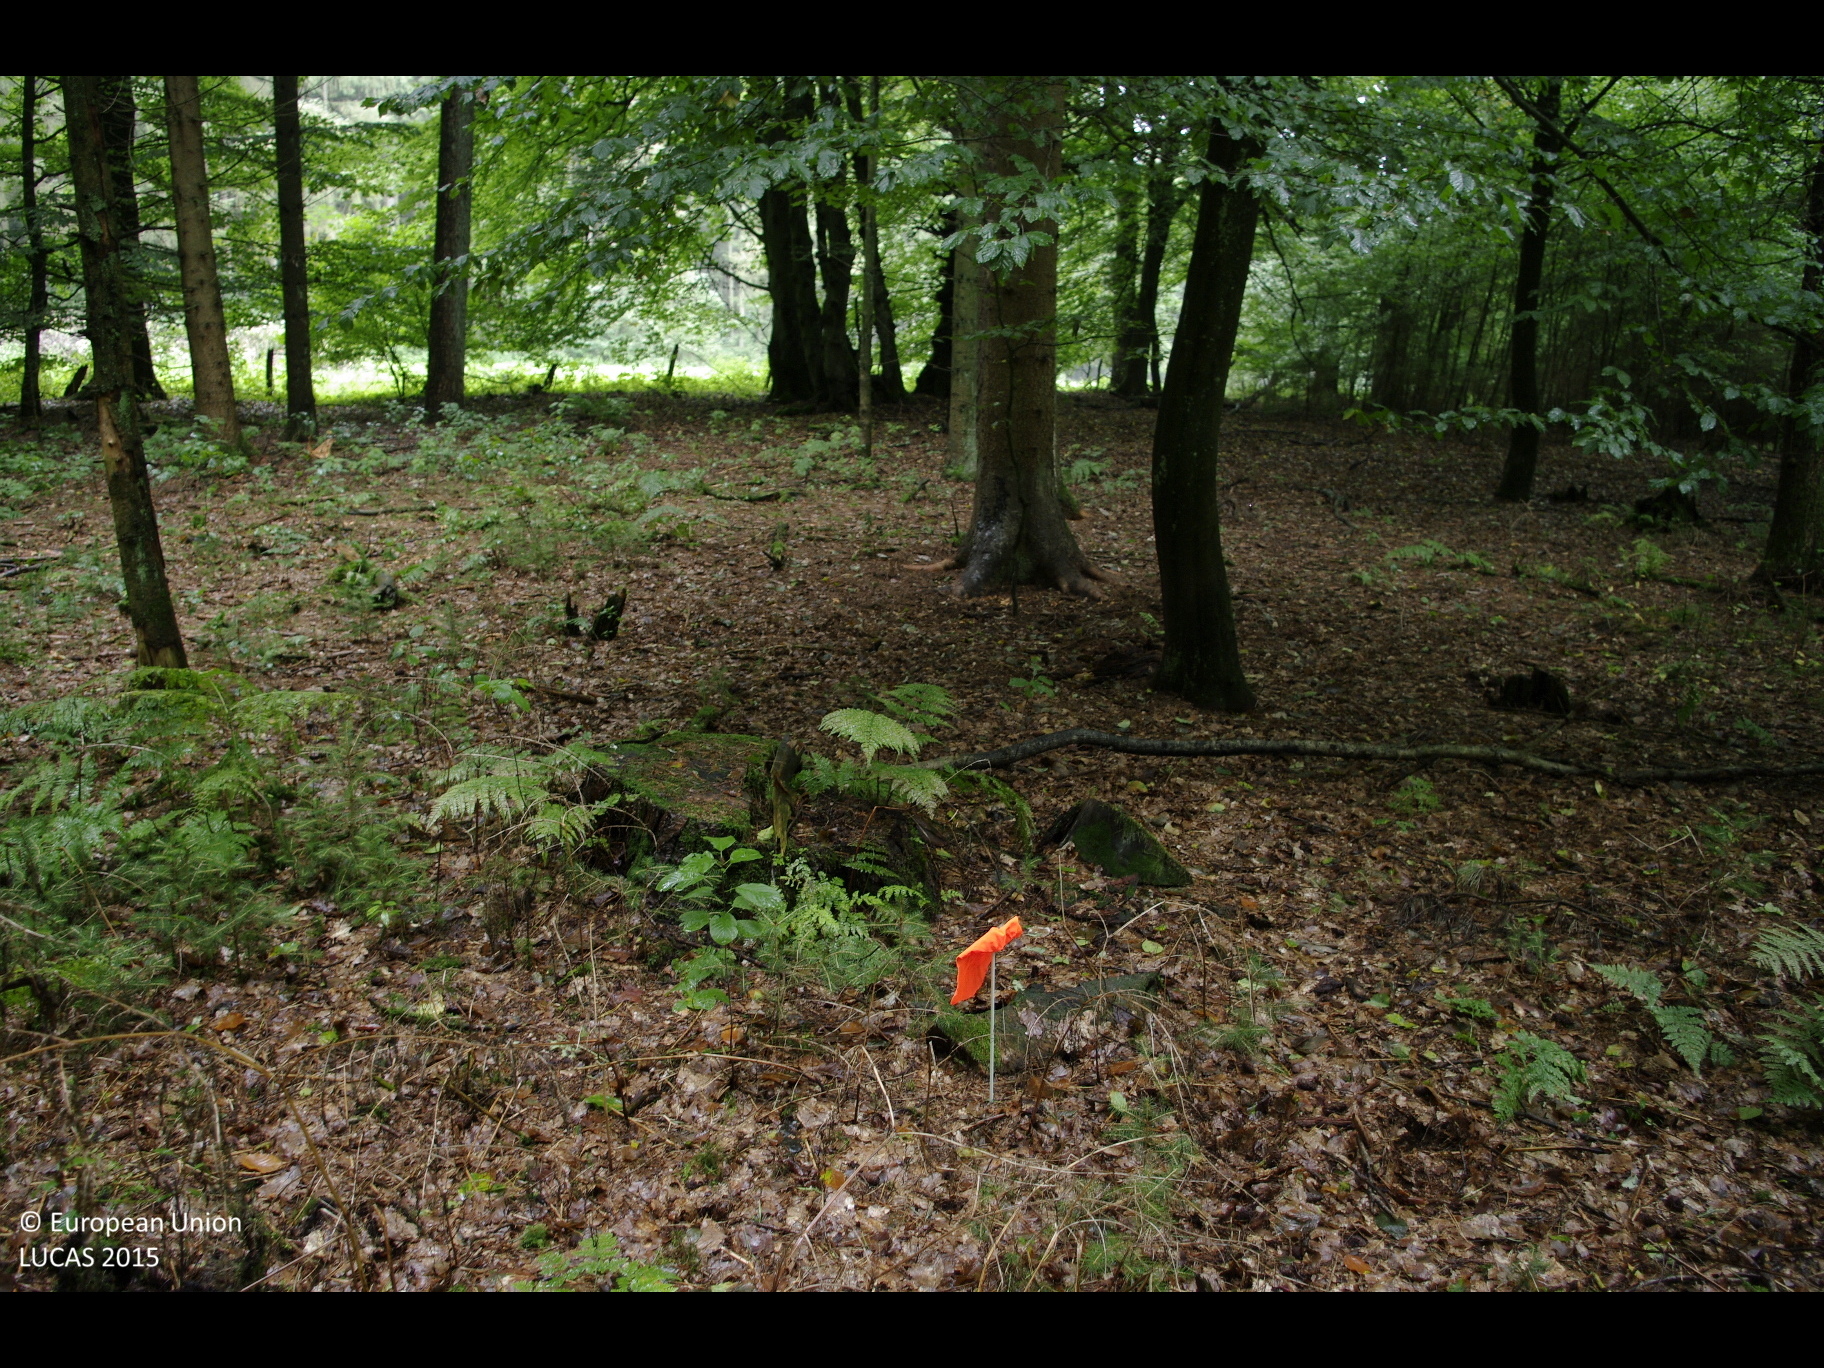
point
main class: Woodland
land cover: Pine dominated mixed woodland
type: hemiboreal forest and nemoral coniferous forest and mixed broadleaved-coniferous forest
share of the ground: > 75 %
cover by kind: coniferous forest trees 50 %, broadleaved forest trees 40 %, herbaceous plants 10 %
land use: Forestry
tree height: > 5 m
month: September
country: DE
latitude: 53.3839
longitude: 9.9249
